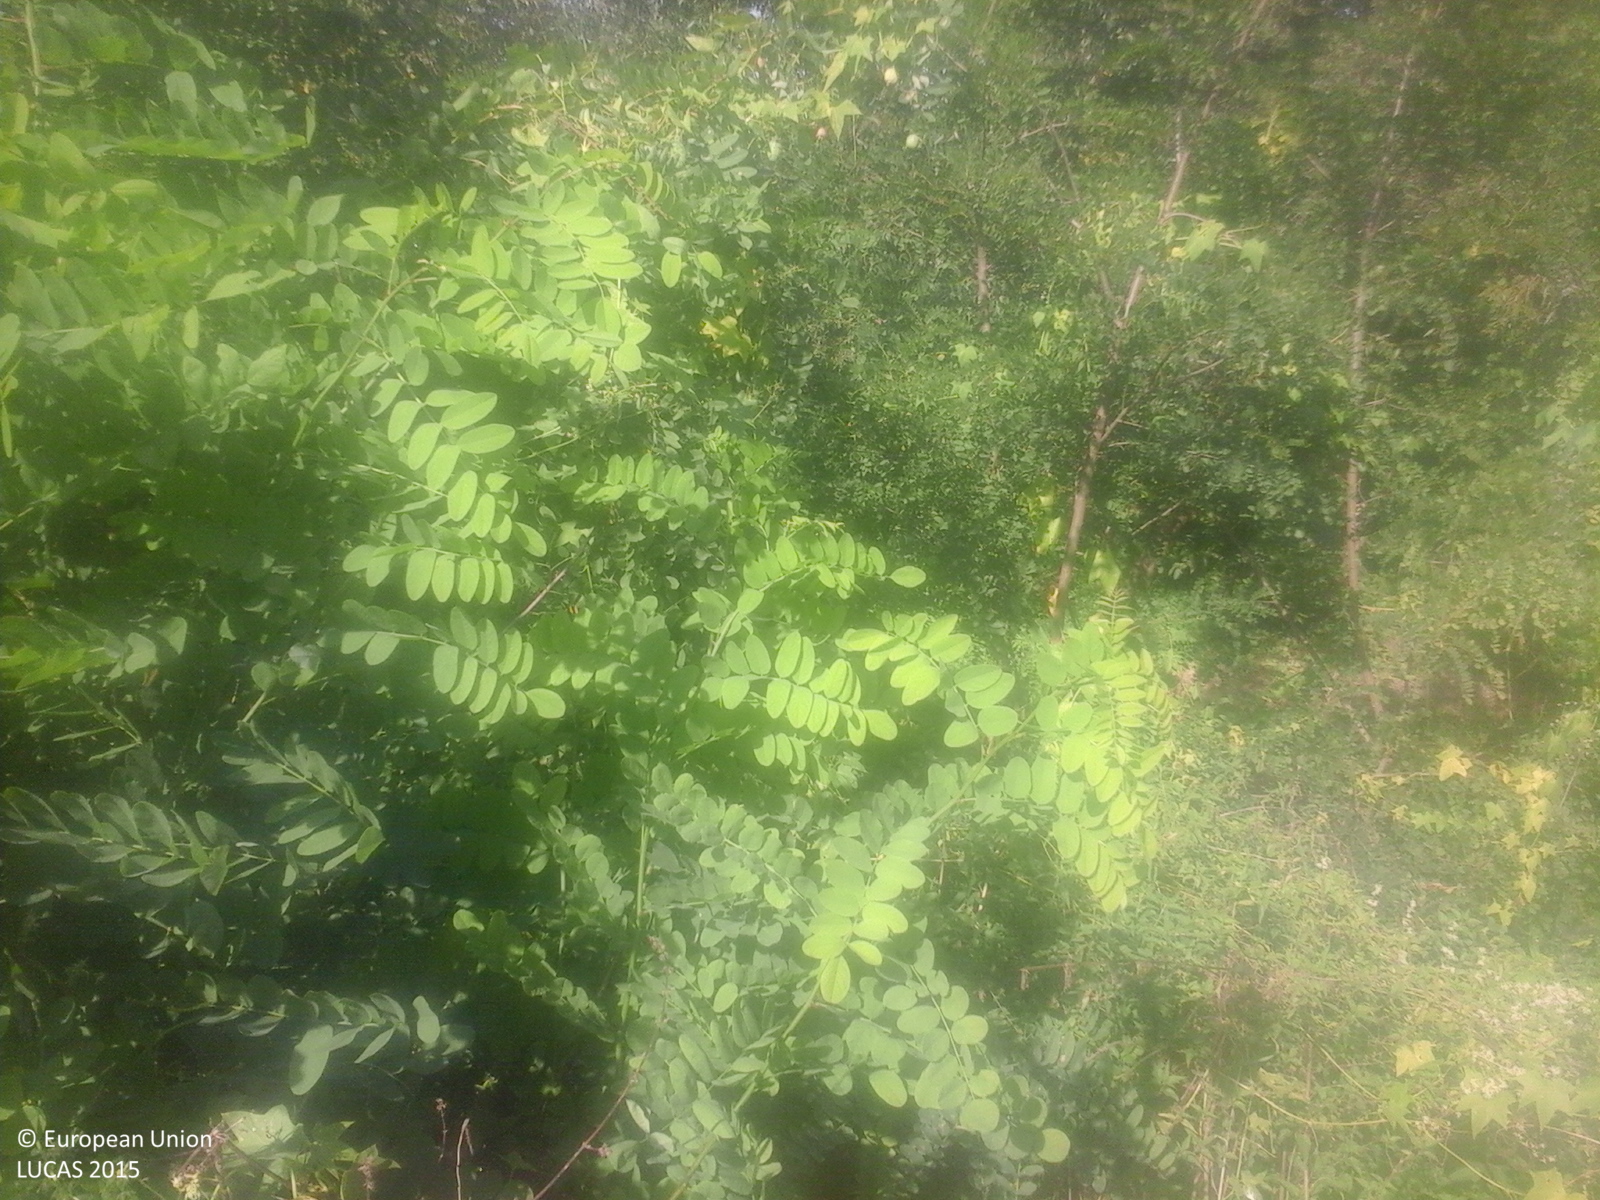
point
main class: Woodland
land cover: Broadleaved woodland
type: exotic forest
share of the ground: > 75 %
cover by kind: broadleaved forest trees 100 %
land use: Forestry
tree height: > 5 m
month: September
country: RO
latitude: 46.9371
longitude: 23.7493
